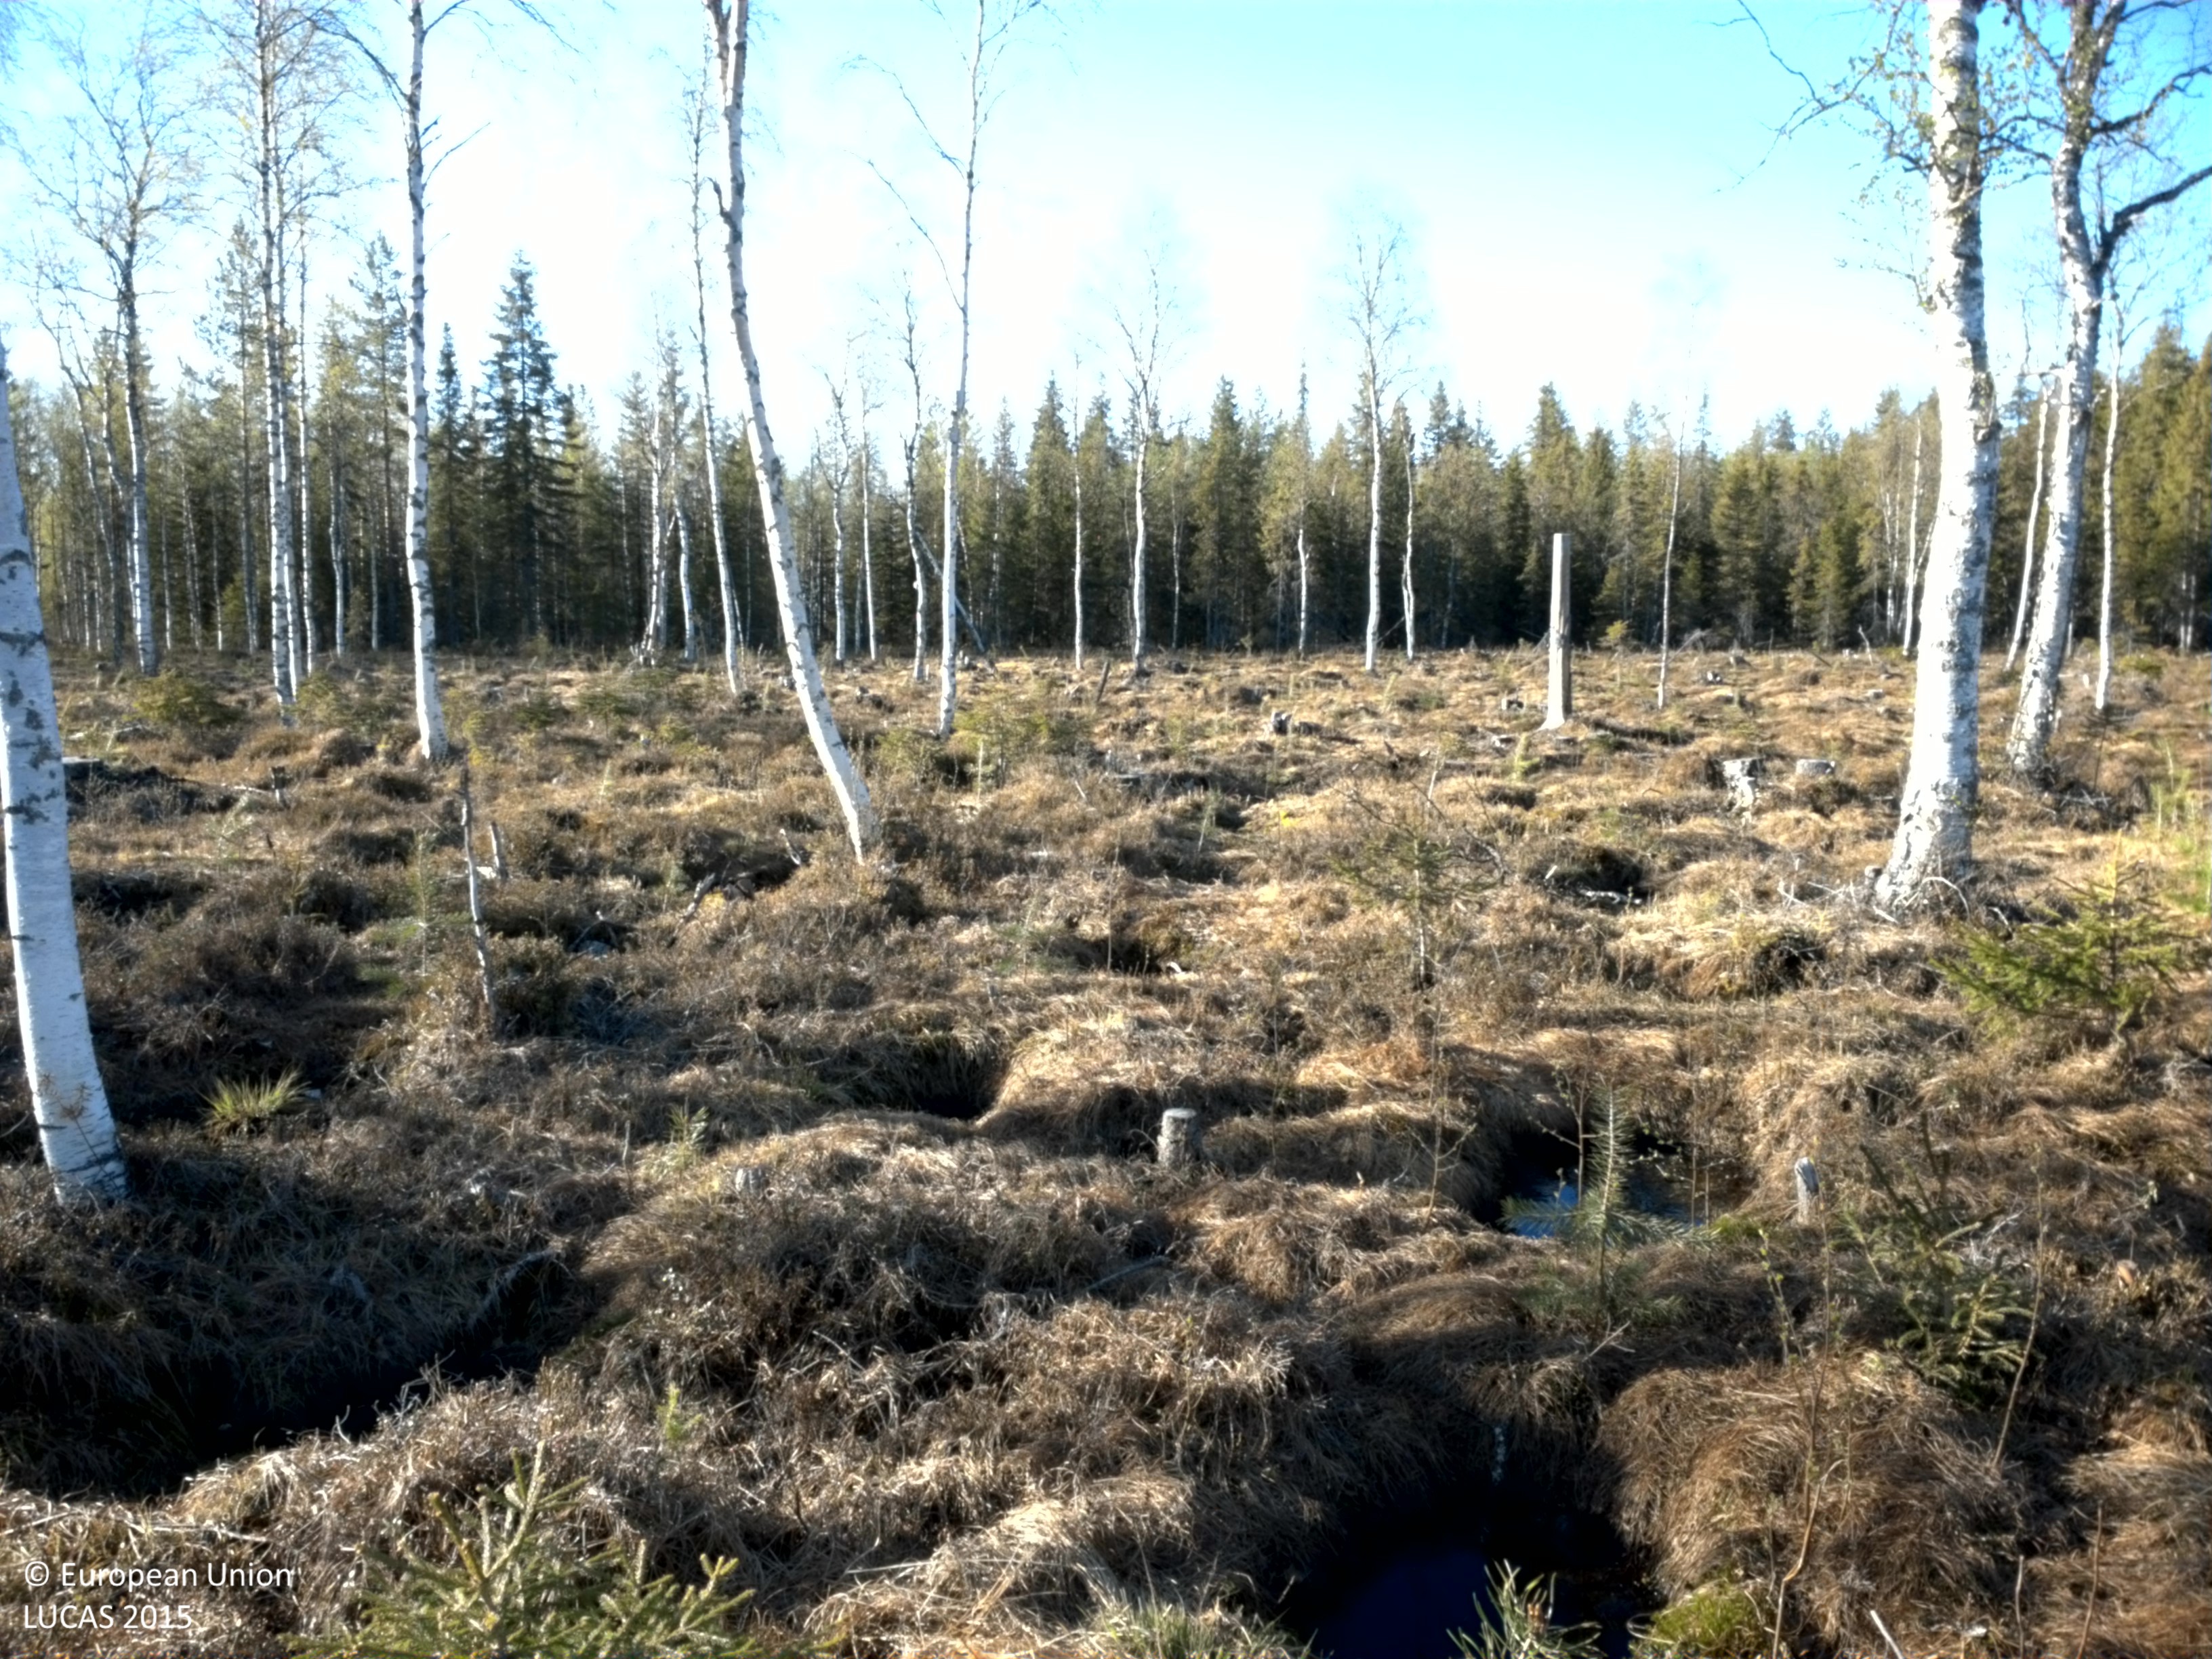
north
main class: Shrubland
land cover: Shrubland with sparse tree cover
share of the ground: 50 - 75 %
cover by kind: shrubs 65 %, herbaceous plants 30 %, broadleaved forest trees 5 %
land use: Forestry
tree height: > 5 m
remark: Clear cut
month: May
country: SE
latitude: 66.0530
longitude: 23.3907
